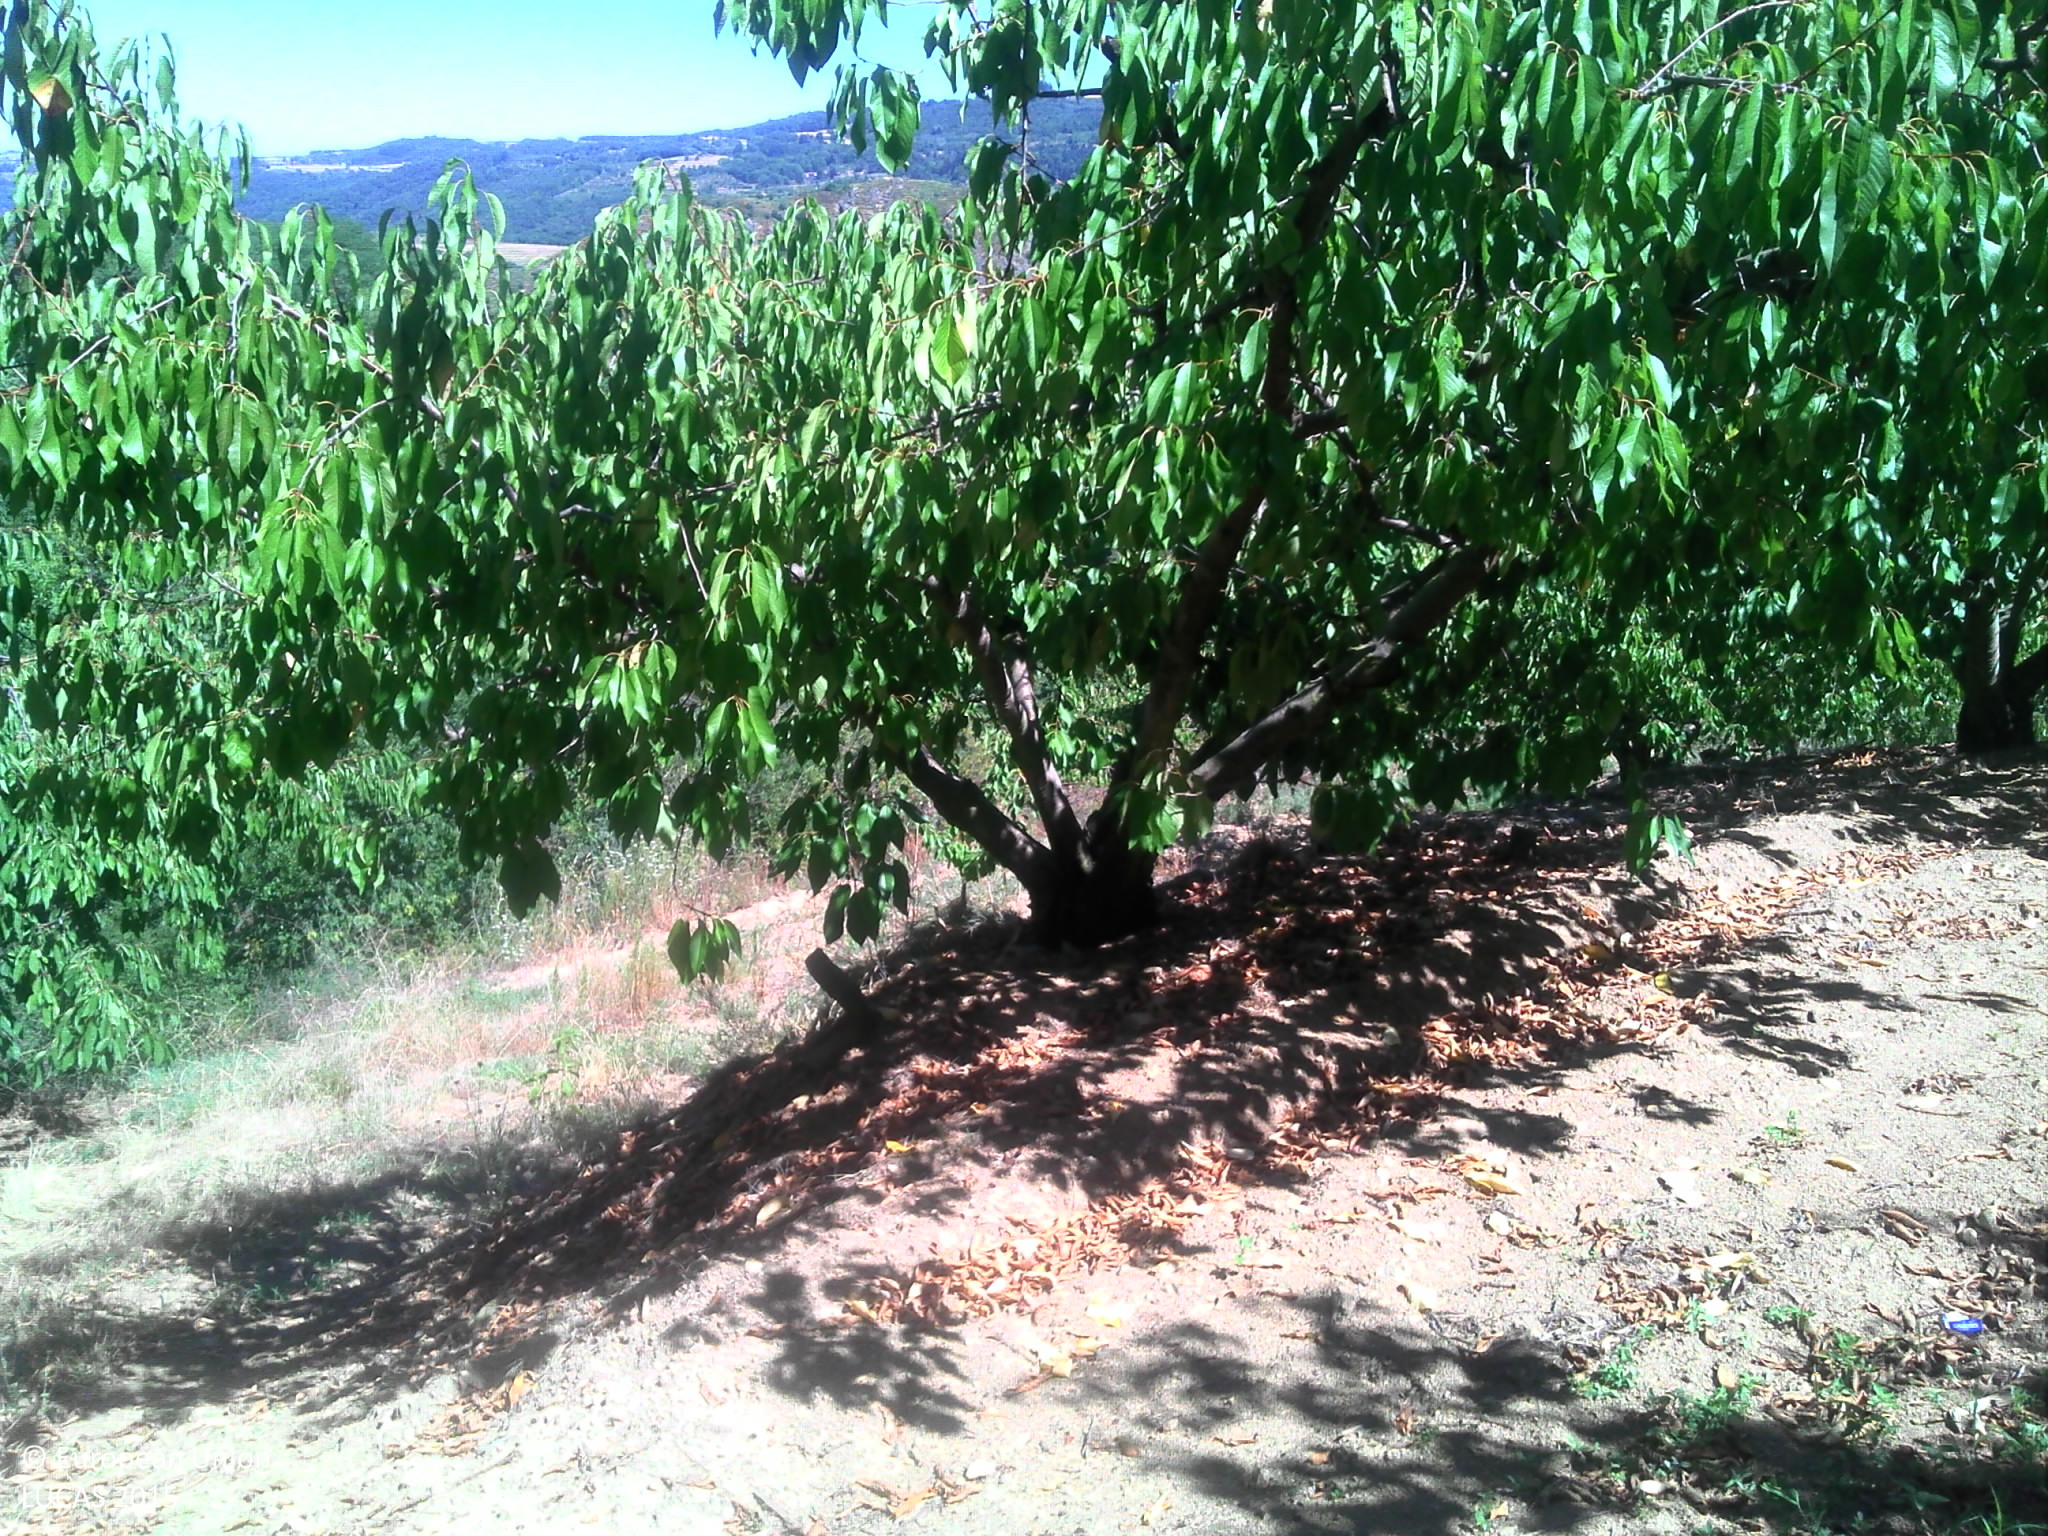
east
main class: Cropland
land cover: Cherry fruit
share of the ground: 50 - 75 %
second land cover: Other bare soil
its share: > 75 %
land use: Agriculture (excluding fallow land and kitchen gardens)
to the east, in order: Cherry fruit; Other bare soil; Managed hedges; Rock outcrops; Paved roads, cycling and walking lanes; Grass margins; Broadleaved woodland; Pine dominated mixed woodland; Tracks; Grassland with sparse tree/shrub cover; Dry stone walls; Pine dominated coniferous woodland; Artificial constructions in urban areas
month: July
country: FR
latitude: 45.0249
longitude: 4.6368
